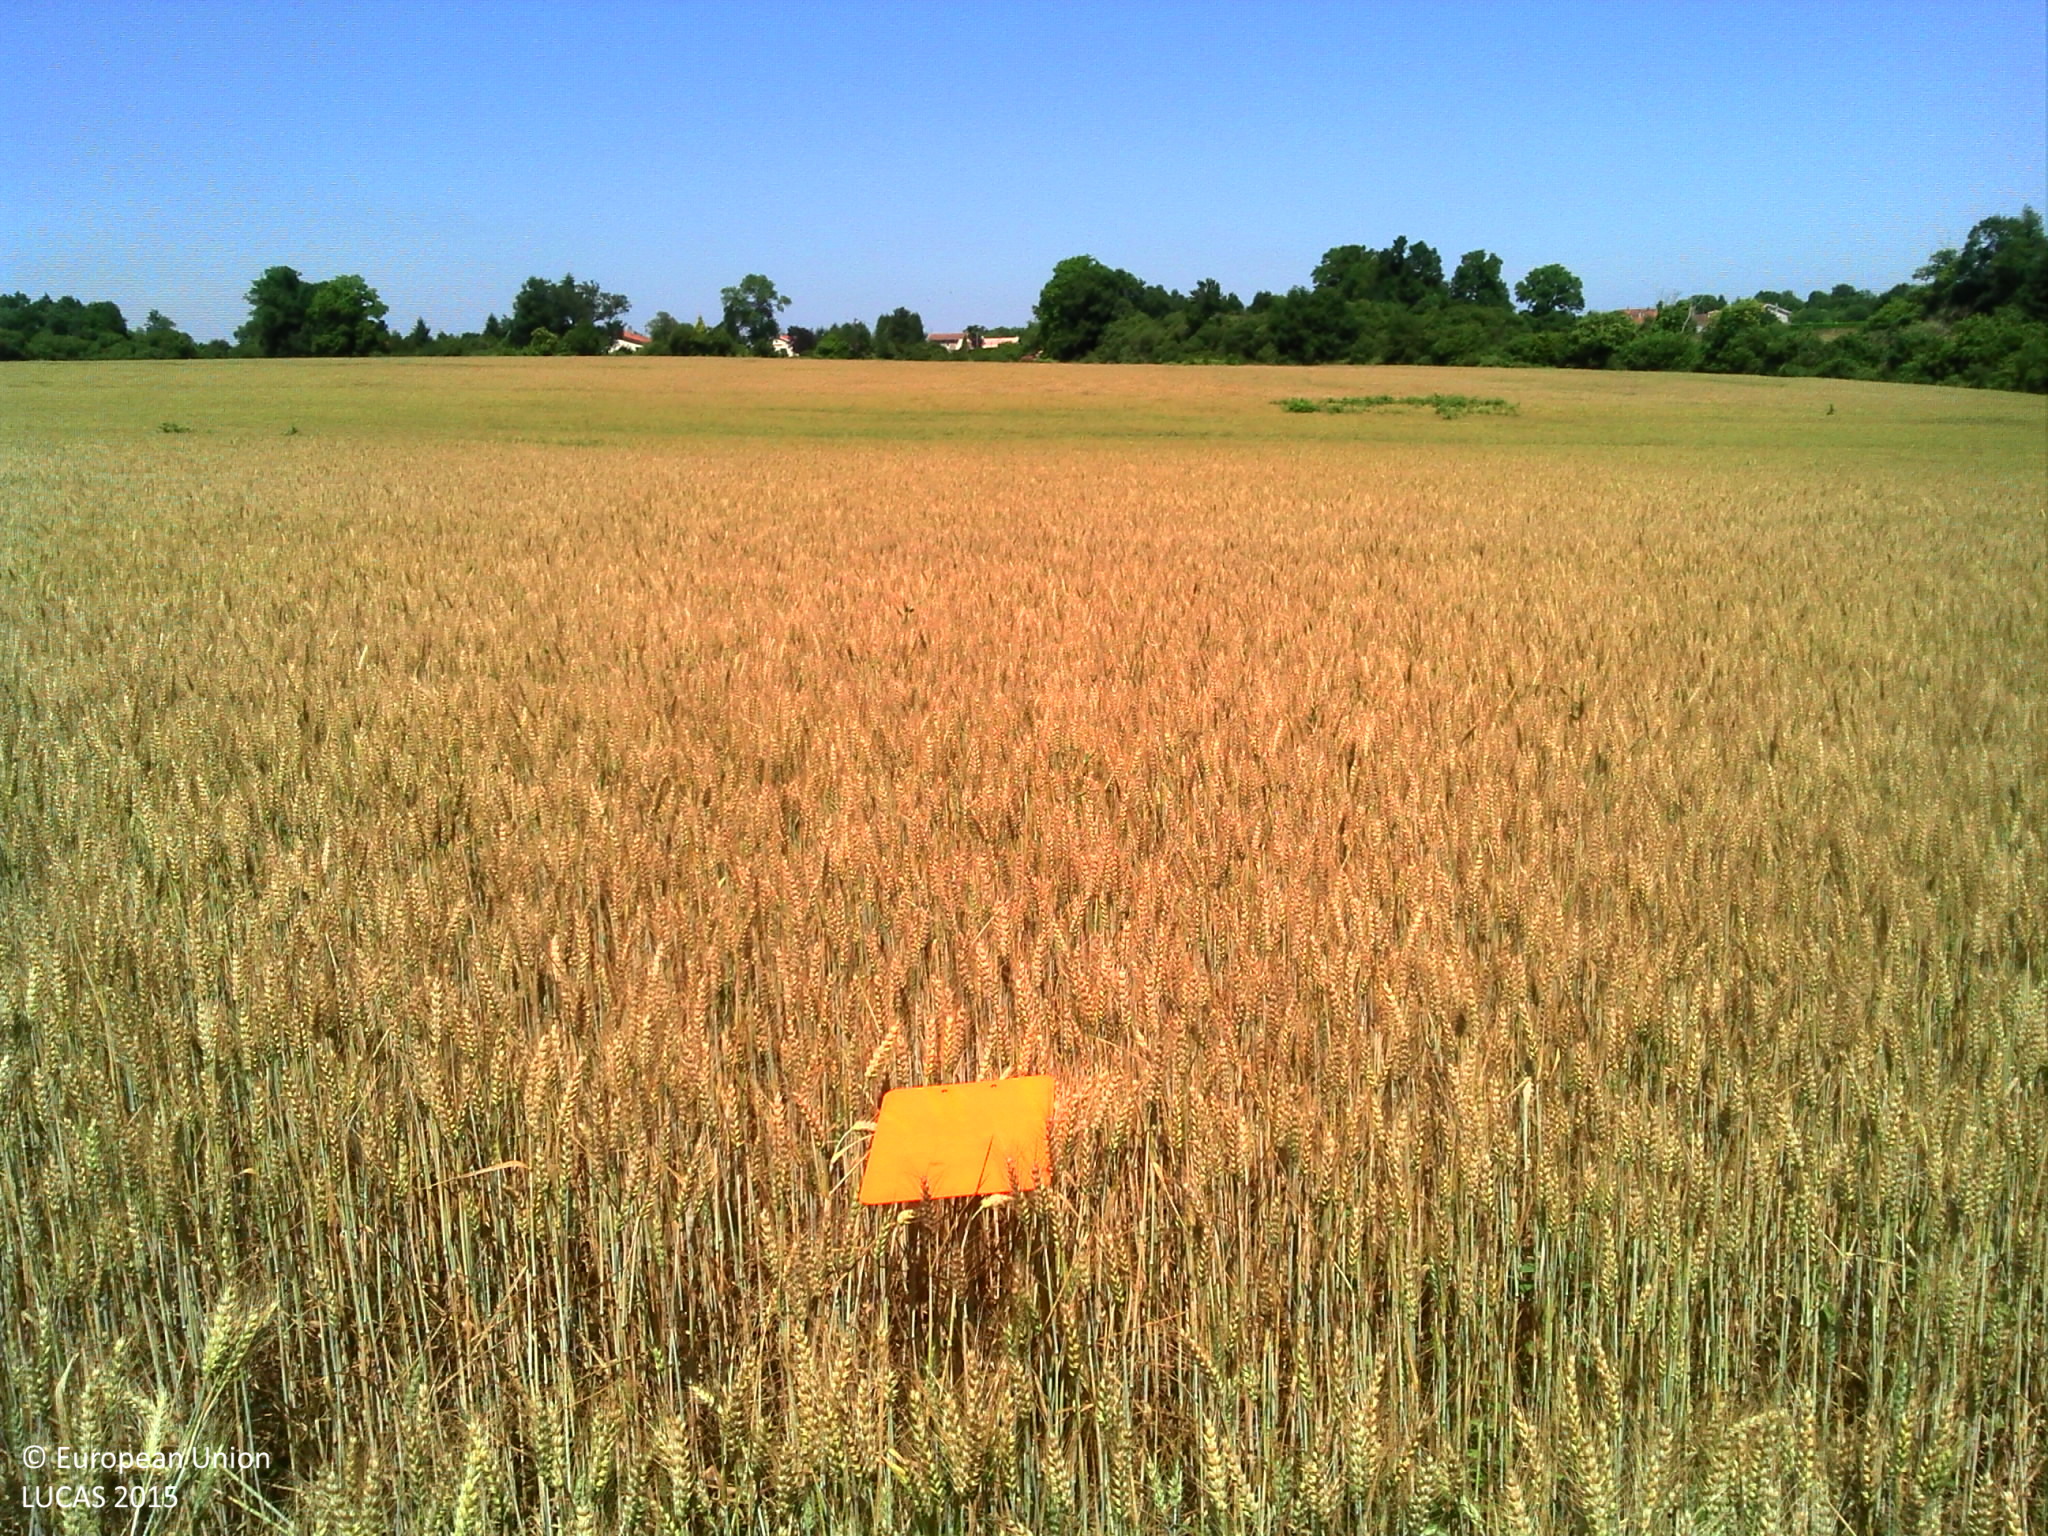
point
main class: Cropland
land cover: Common wheat
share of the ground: > 75 %
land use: Agriculture (excluding fallow land and kitchen gardens)
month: June
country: FR
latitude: 45.8970
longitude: 0.5642
